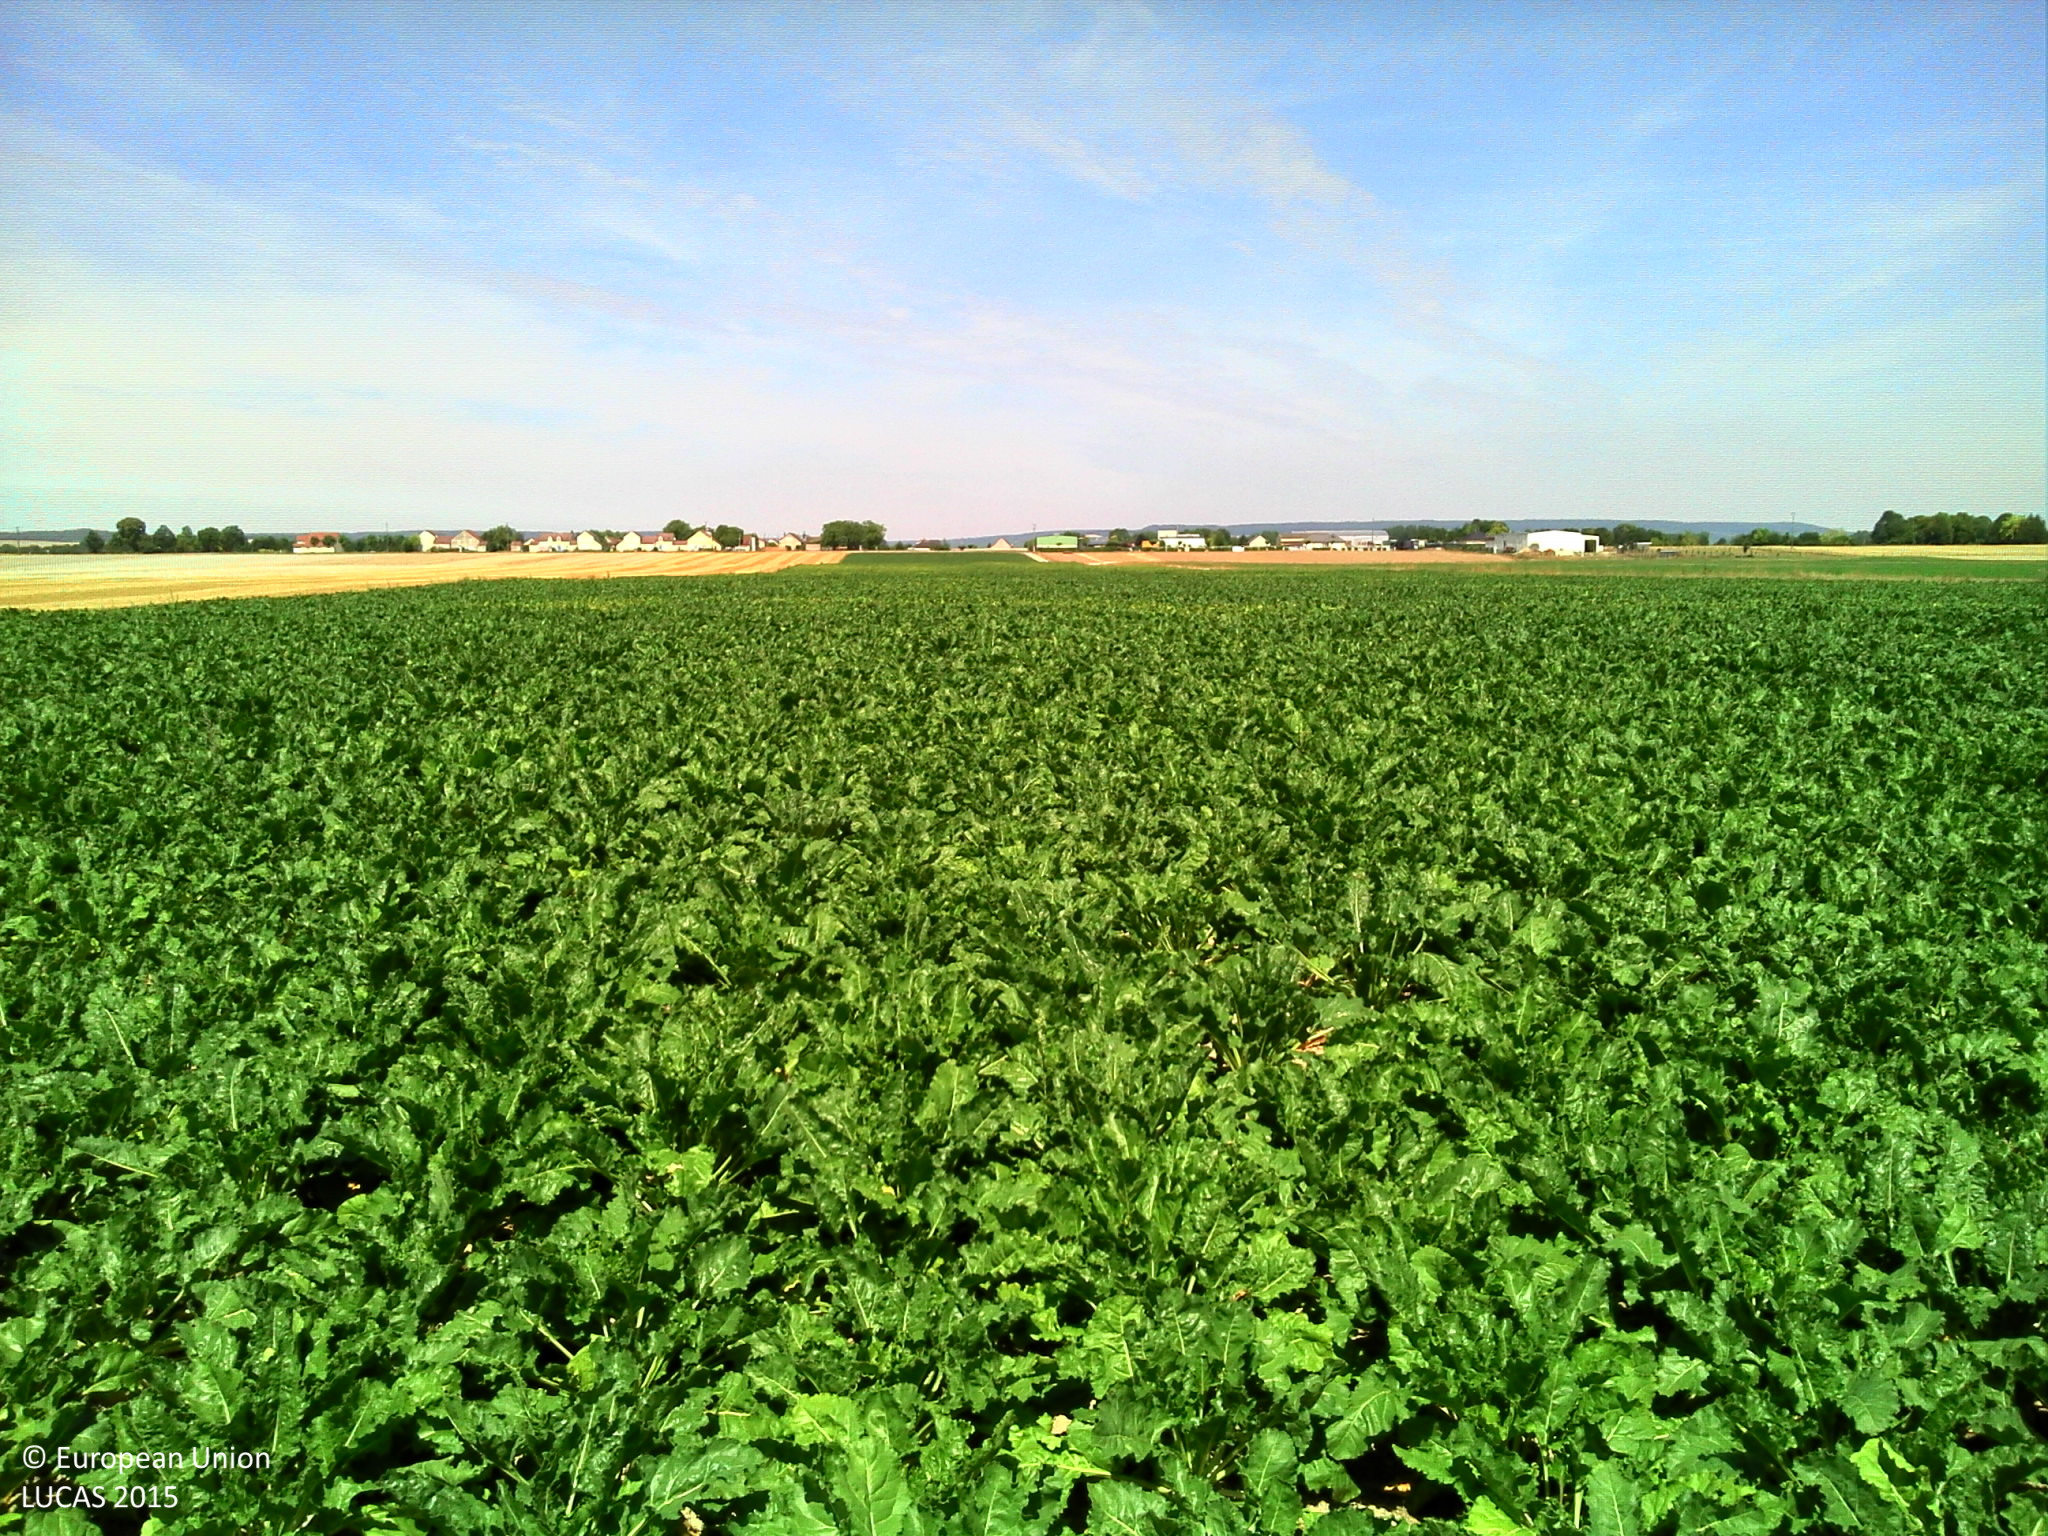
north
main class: Cropland
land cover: Sugar beet
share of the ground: > 75 %
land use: Agriculture (excluding fallow land and kitchen gardens)
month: August
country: FR
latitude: 49.0052
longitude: 4.1310
